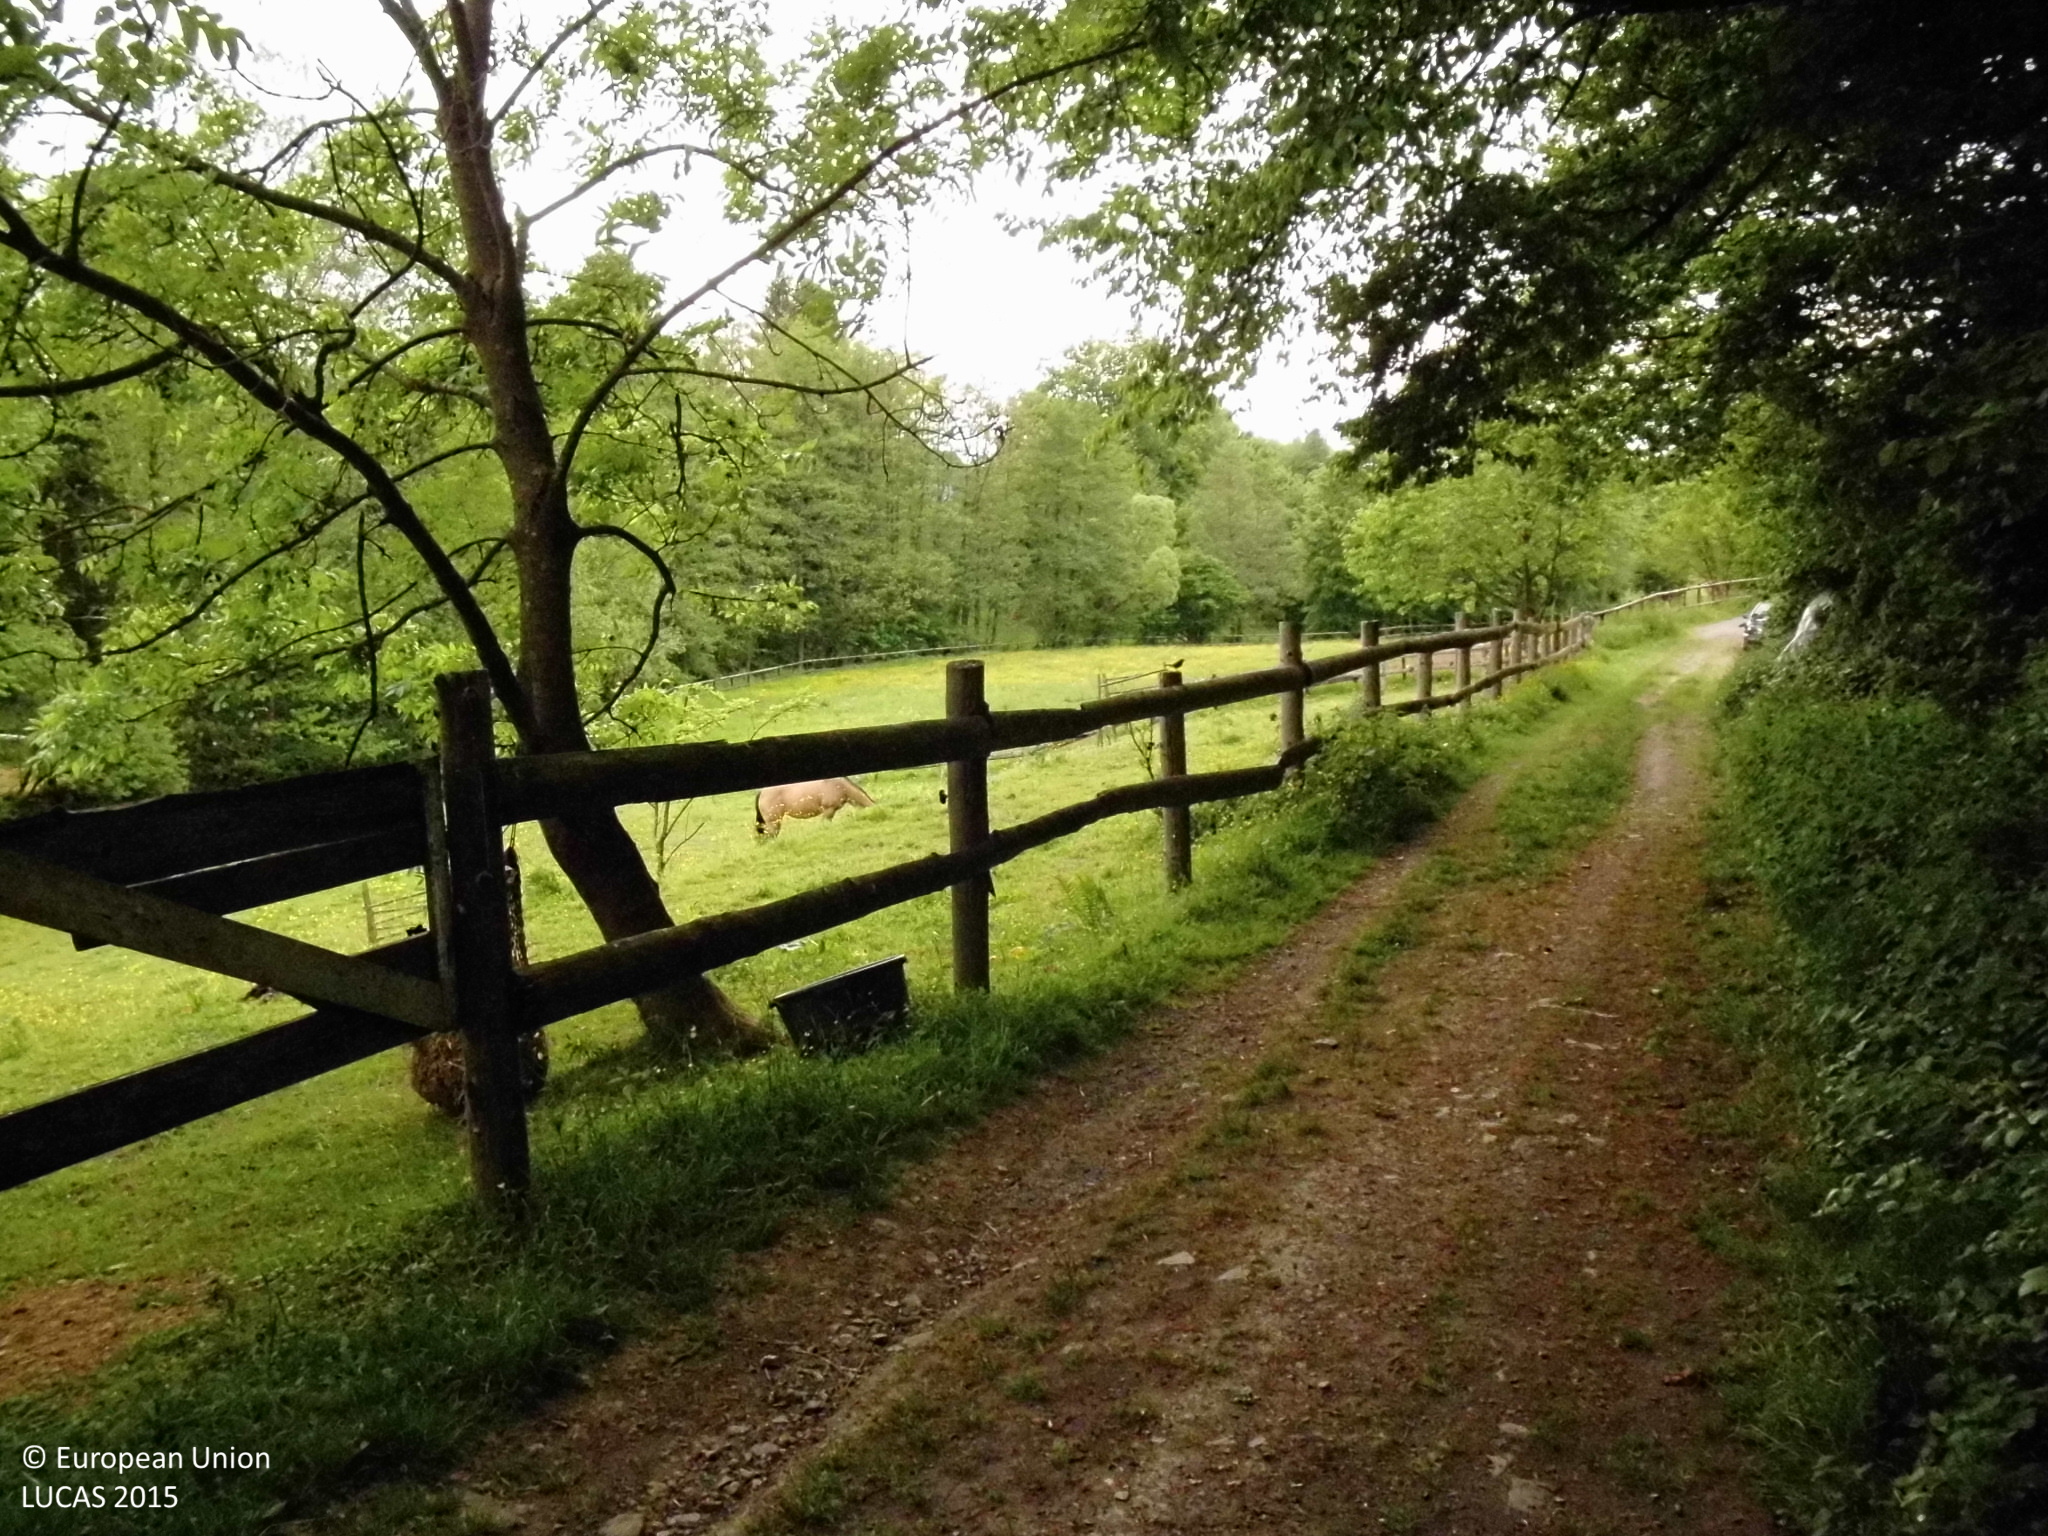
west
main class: Woodland
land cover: Broadleaved woodland
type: mesophytic deciduous forest
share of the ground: > 75 %
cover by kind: broadleaved forest trees 100 %
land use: Forestry
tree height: > 5 m
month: May
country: DE
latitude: 50.8761
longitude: 7.4847
